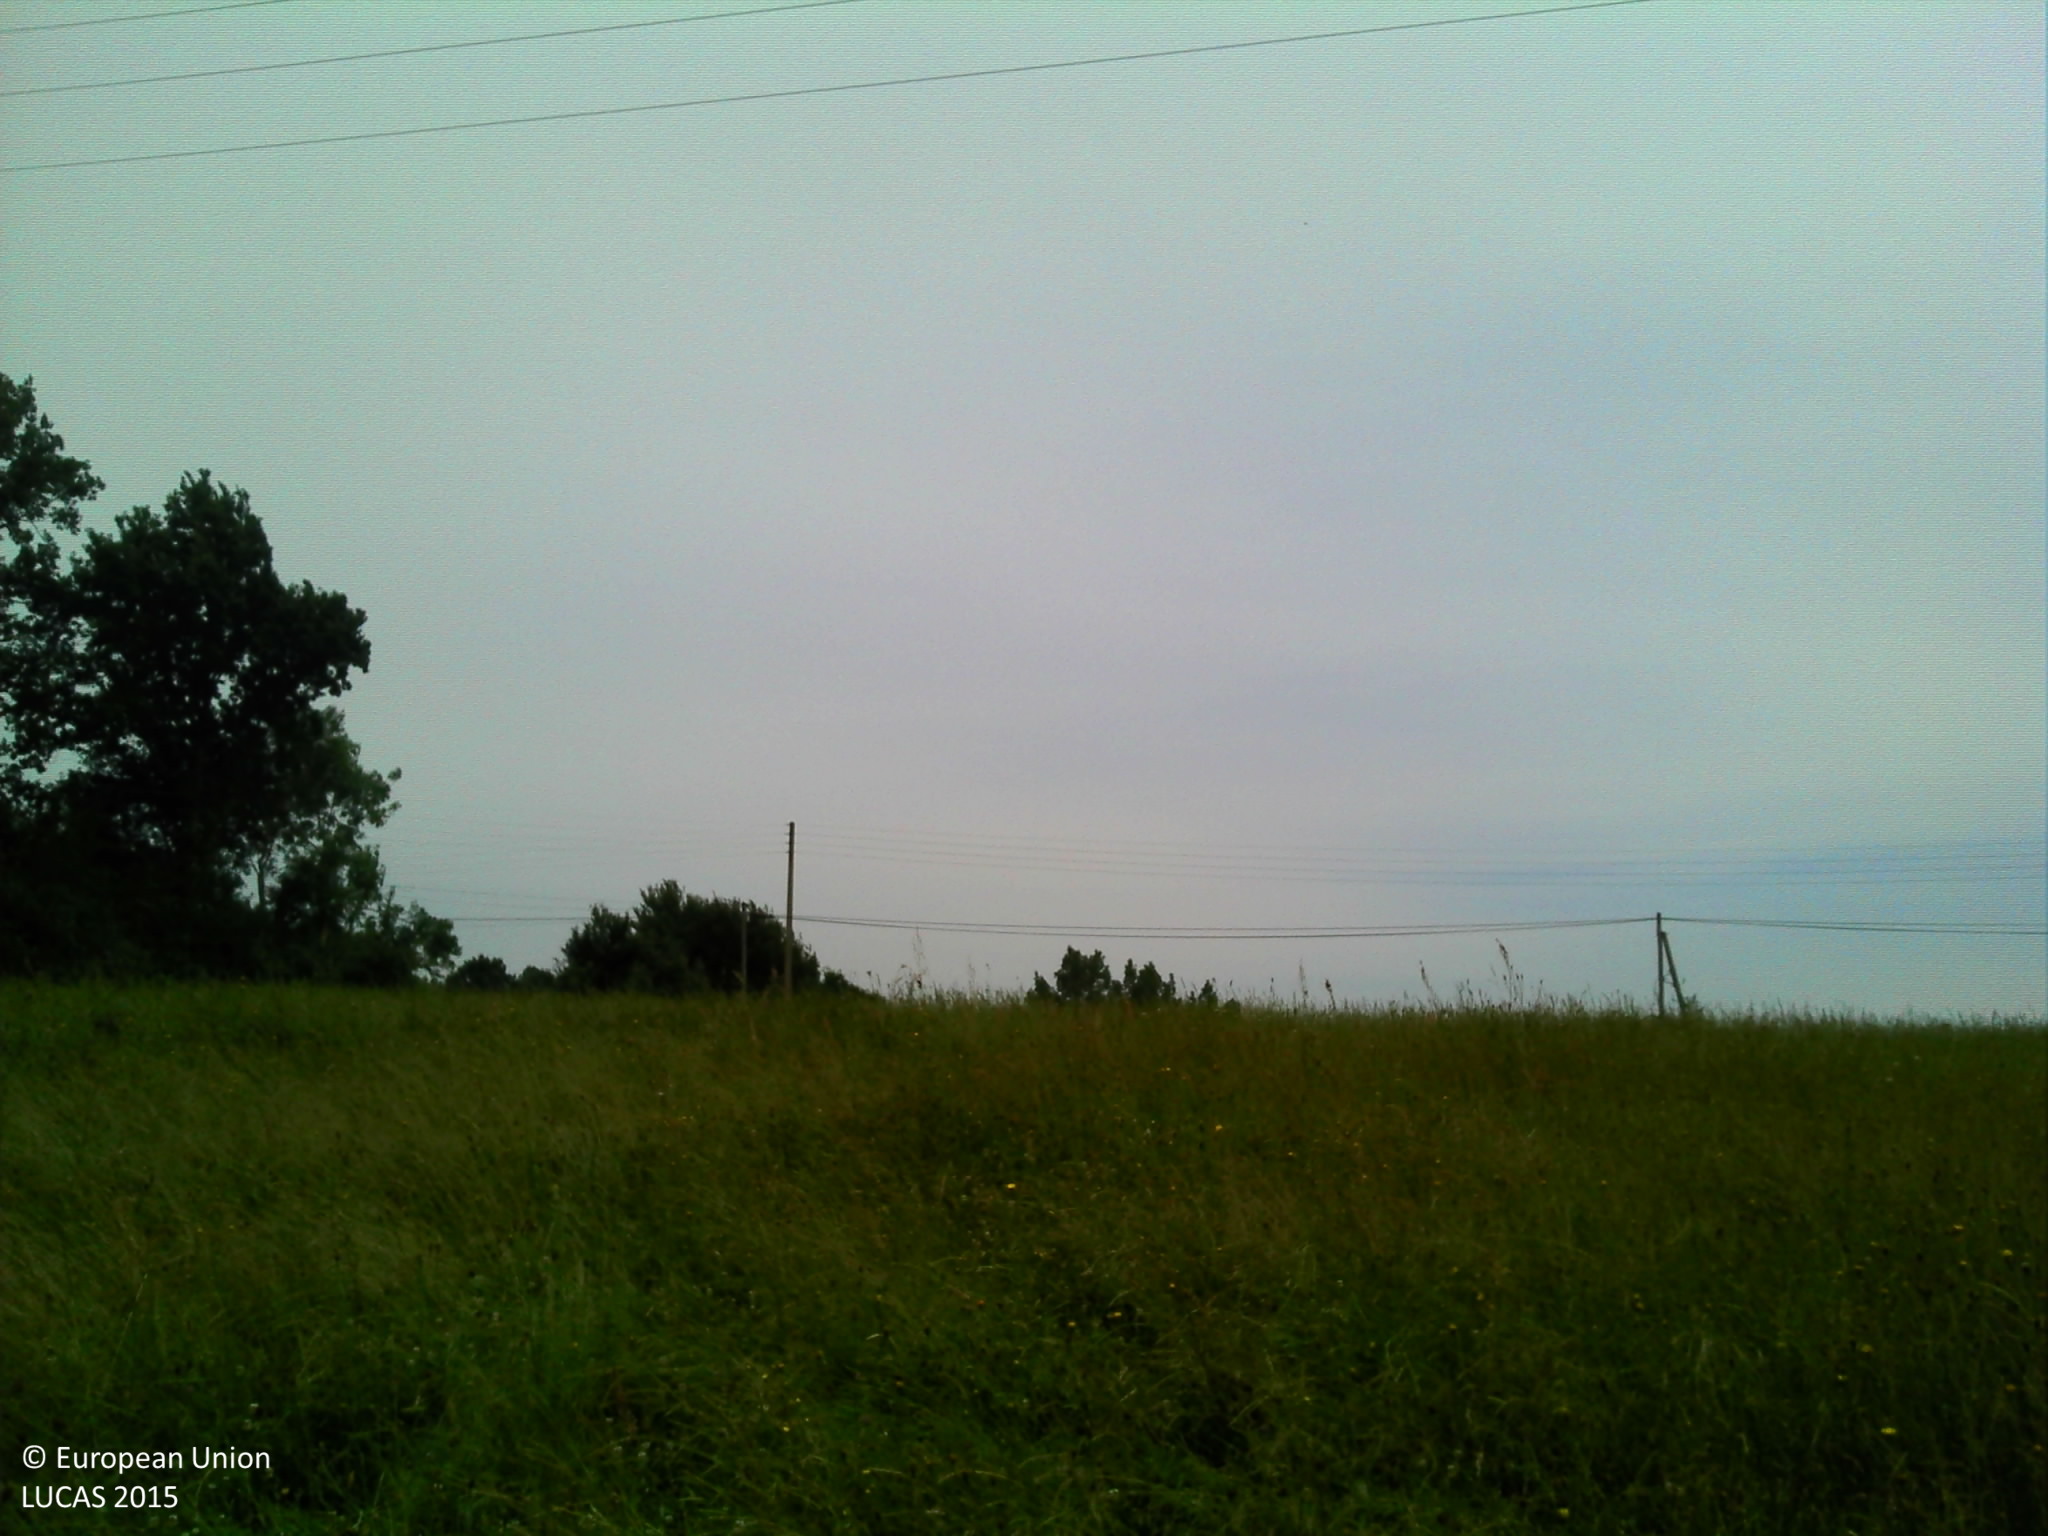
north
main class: Grassland
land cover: Grassland without tree/shrub cover
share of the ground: > 75 %
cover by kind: herbaceous plants 100 %
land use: Agriculture (excluding fallow land and kitchen gardens)
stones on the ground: < 10 %
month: June
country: FR
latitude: 48.3405
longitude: -0.0810
